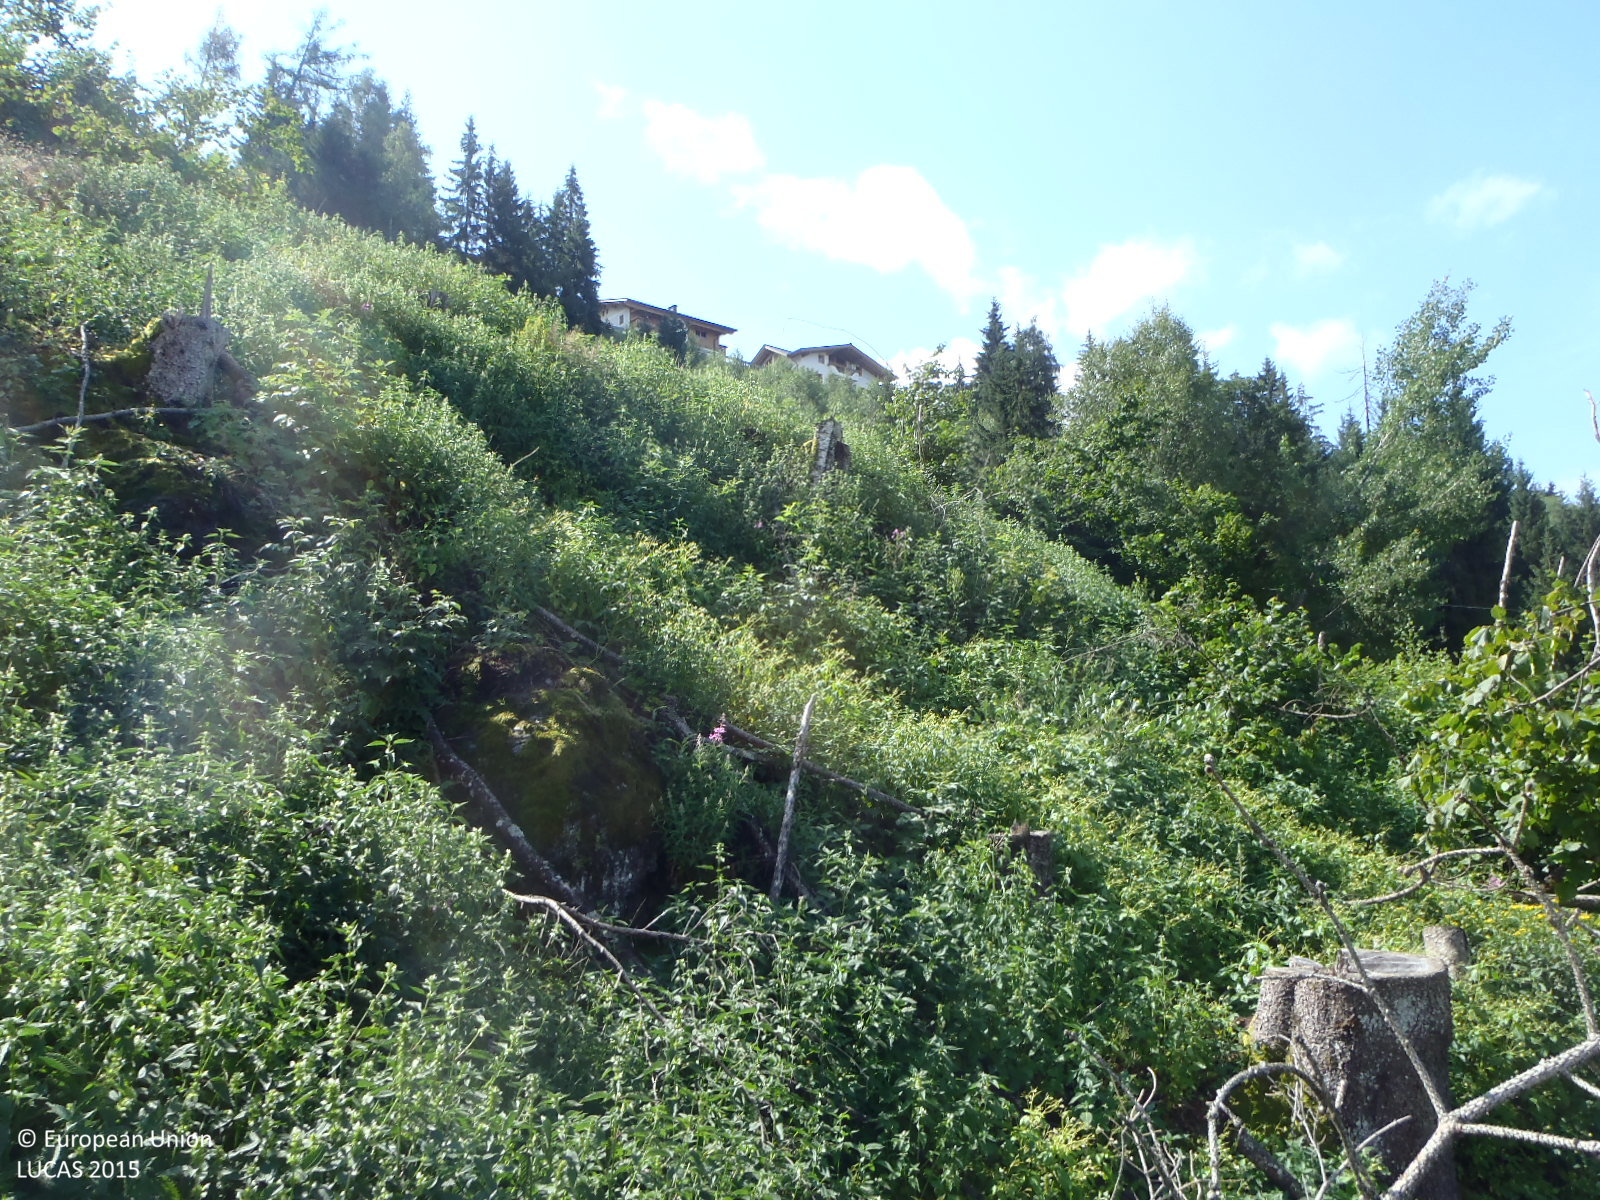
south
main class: Shrubland
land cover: Shrubland with sparse tree cover
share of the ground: > 75 %
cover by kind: shrubs 95 %, broadleaved forest trees 5 %
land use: Forestry
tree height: < 5 m
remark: Clear cut
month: July
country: AT
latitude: 47.2347
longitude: 11.9137
